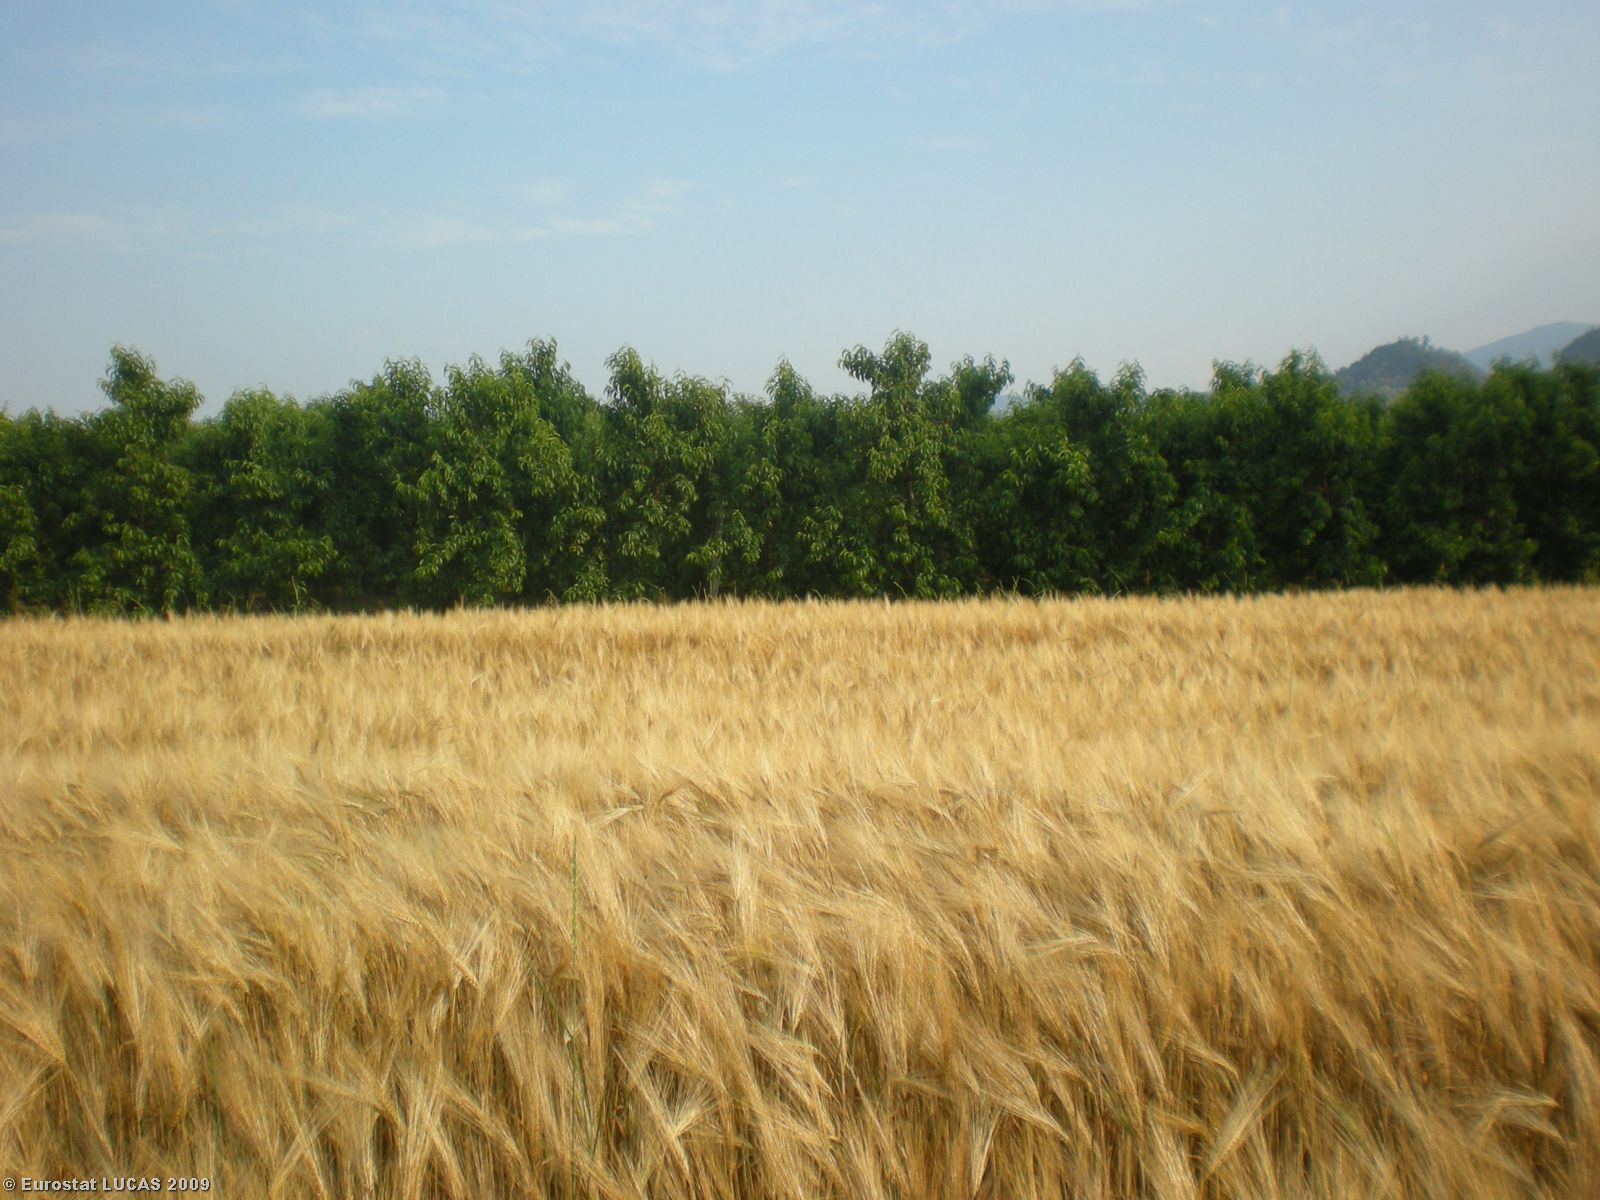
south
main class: Cropland
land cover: Barley
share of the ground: > 75 %
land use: Agriculture (excluding fallow land and kitchen gardens)
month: June
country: IT
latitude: 44.6787
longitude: 7.3936
